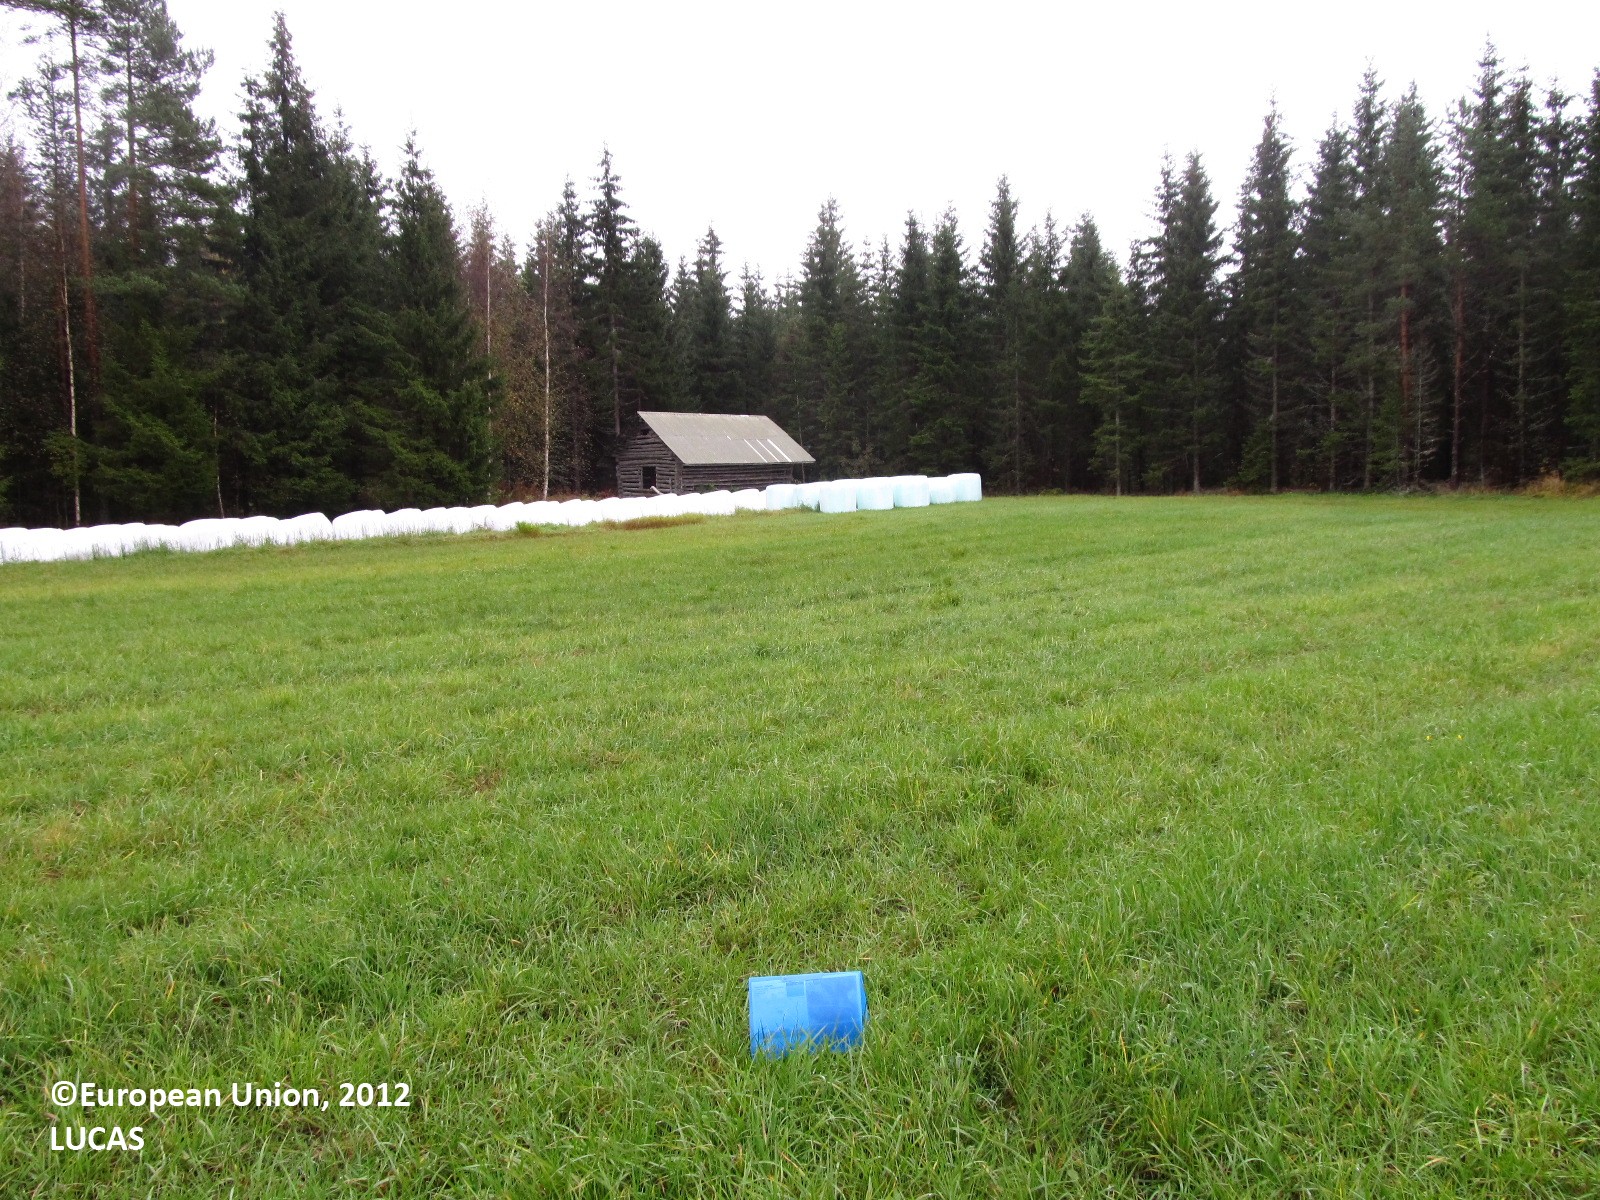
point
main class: Cropland
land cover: Temporary grasslands
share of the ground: > 75 %
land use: Agriculture (excluding fallow land and kitchen gardens)
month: September
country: FI
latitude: 62.5045
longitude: 27.9471
